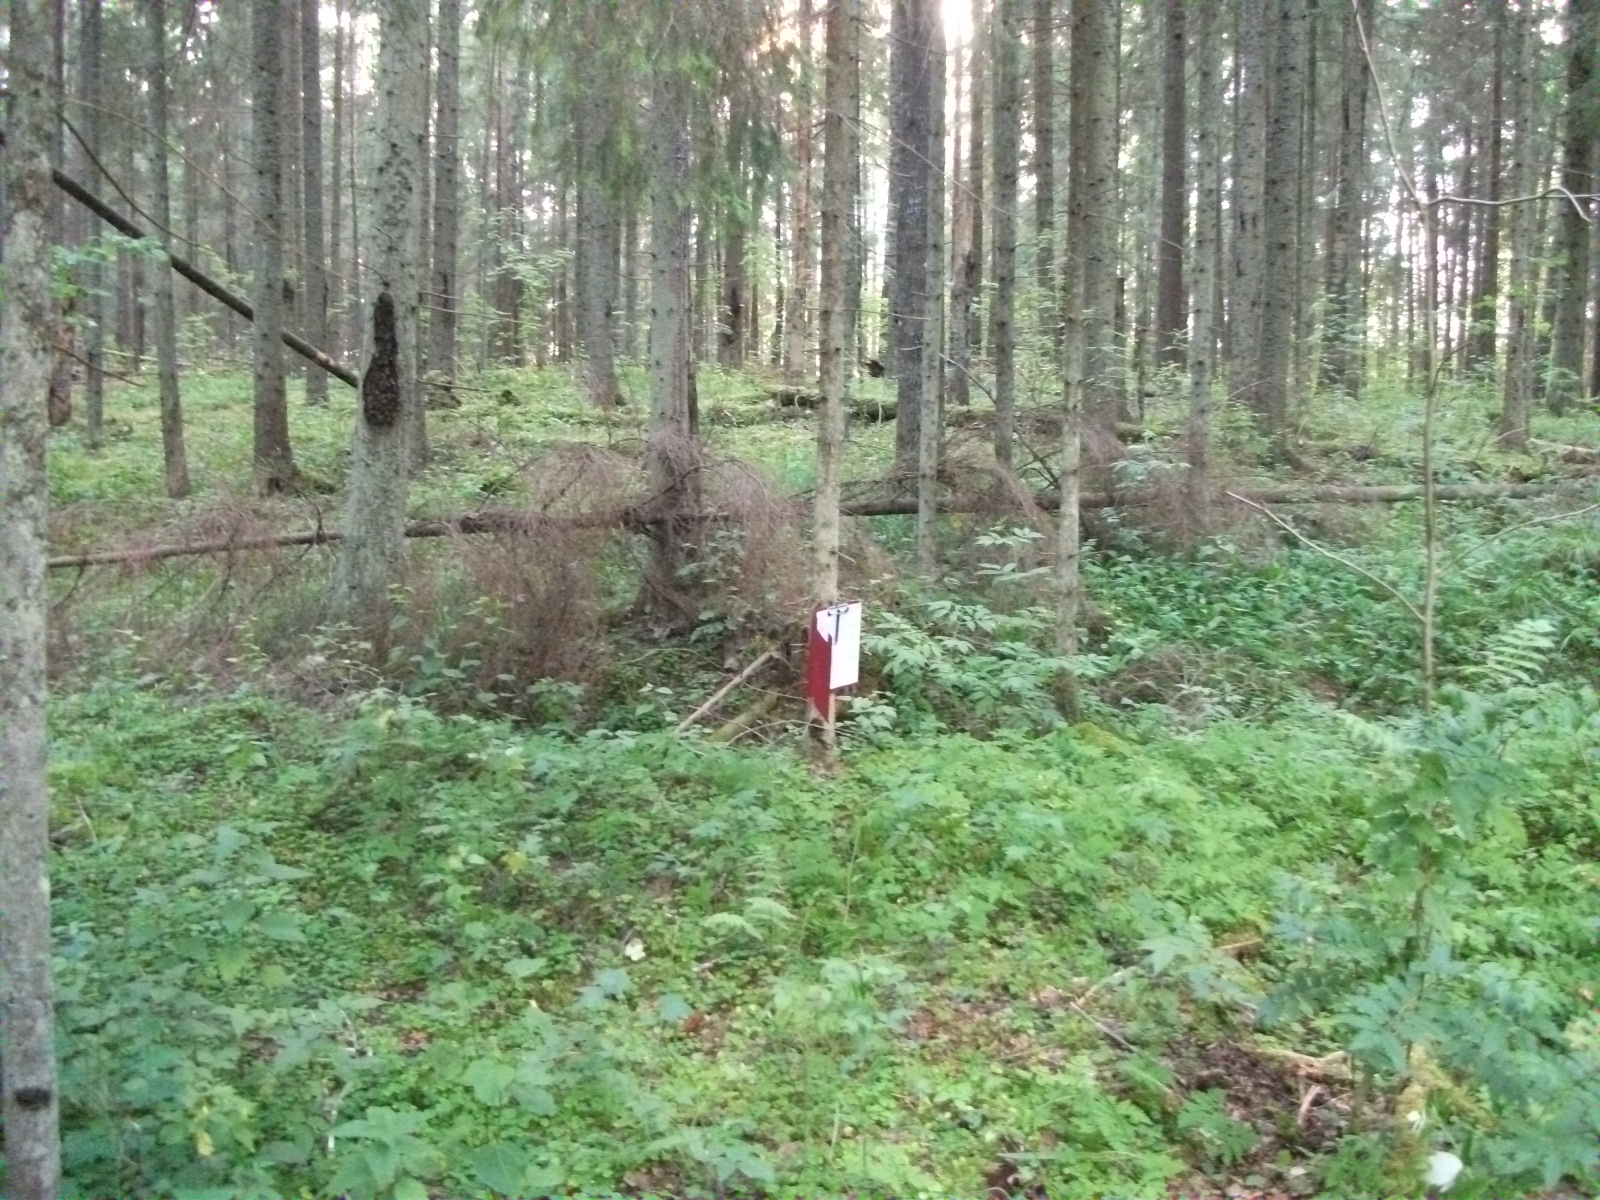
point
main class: Woodland
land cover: Spruce dominated mixed woodland
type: hemiboreal forest and nemoral coniferous forest and mixed broadleaved-coniferous forest
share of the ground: > 75 %
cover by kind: coniferous forest trees 60 %, broadleaved forest trees 25 %, shrubs 5 %, herbaceous plants 5 %, lichens and mosses 5 %
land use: Forestry
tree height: > 5 m
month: July
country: LV
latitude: 57.1382
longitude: 26.3163
